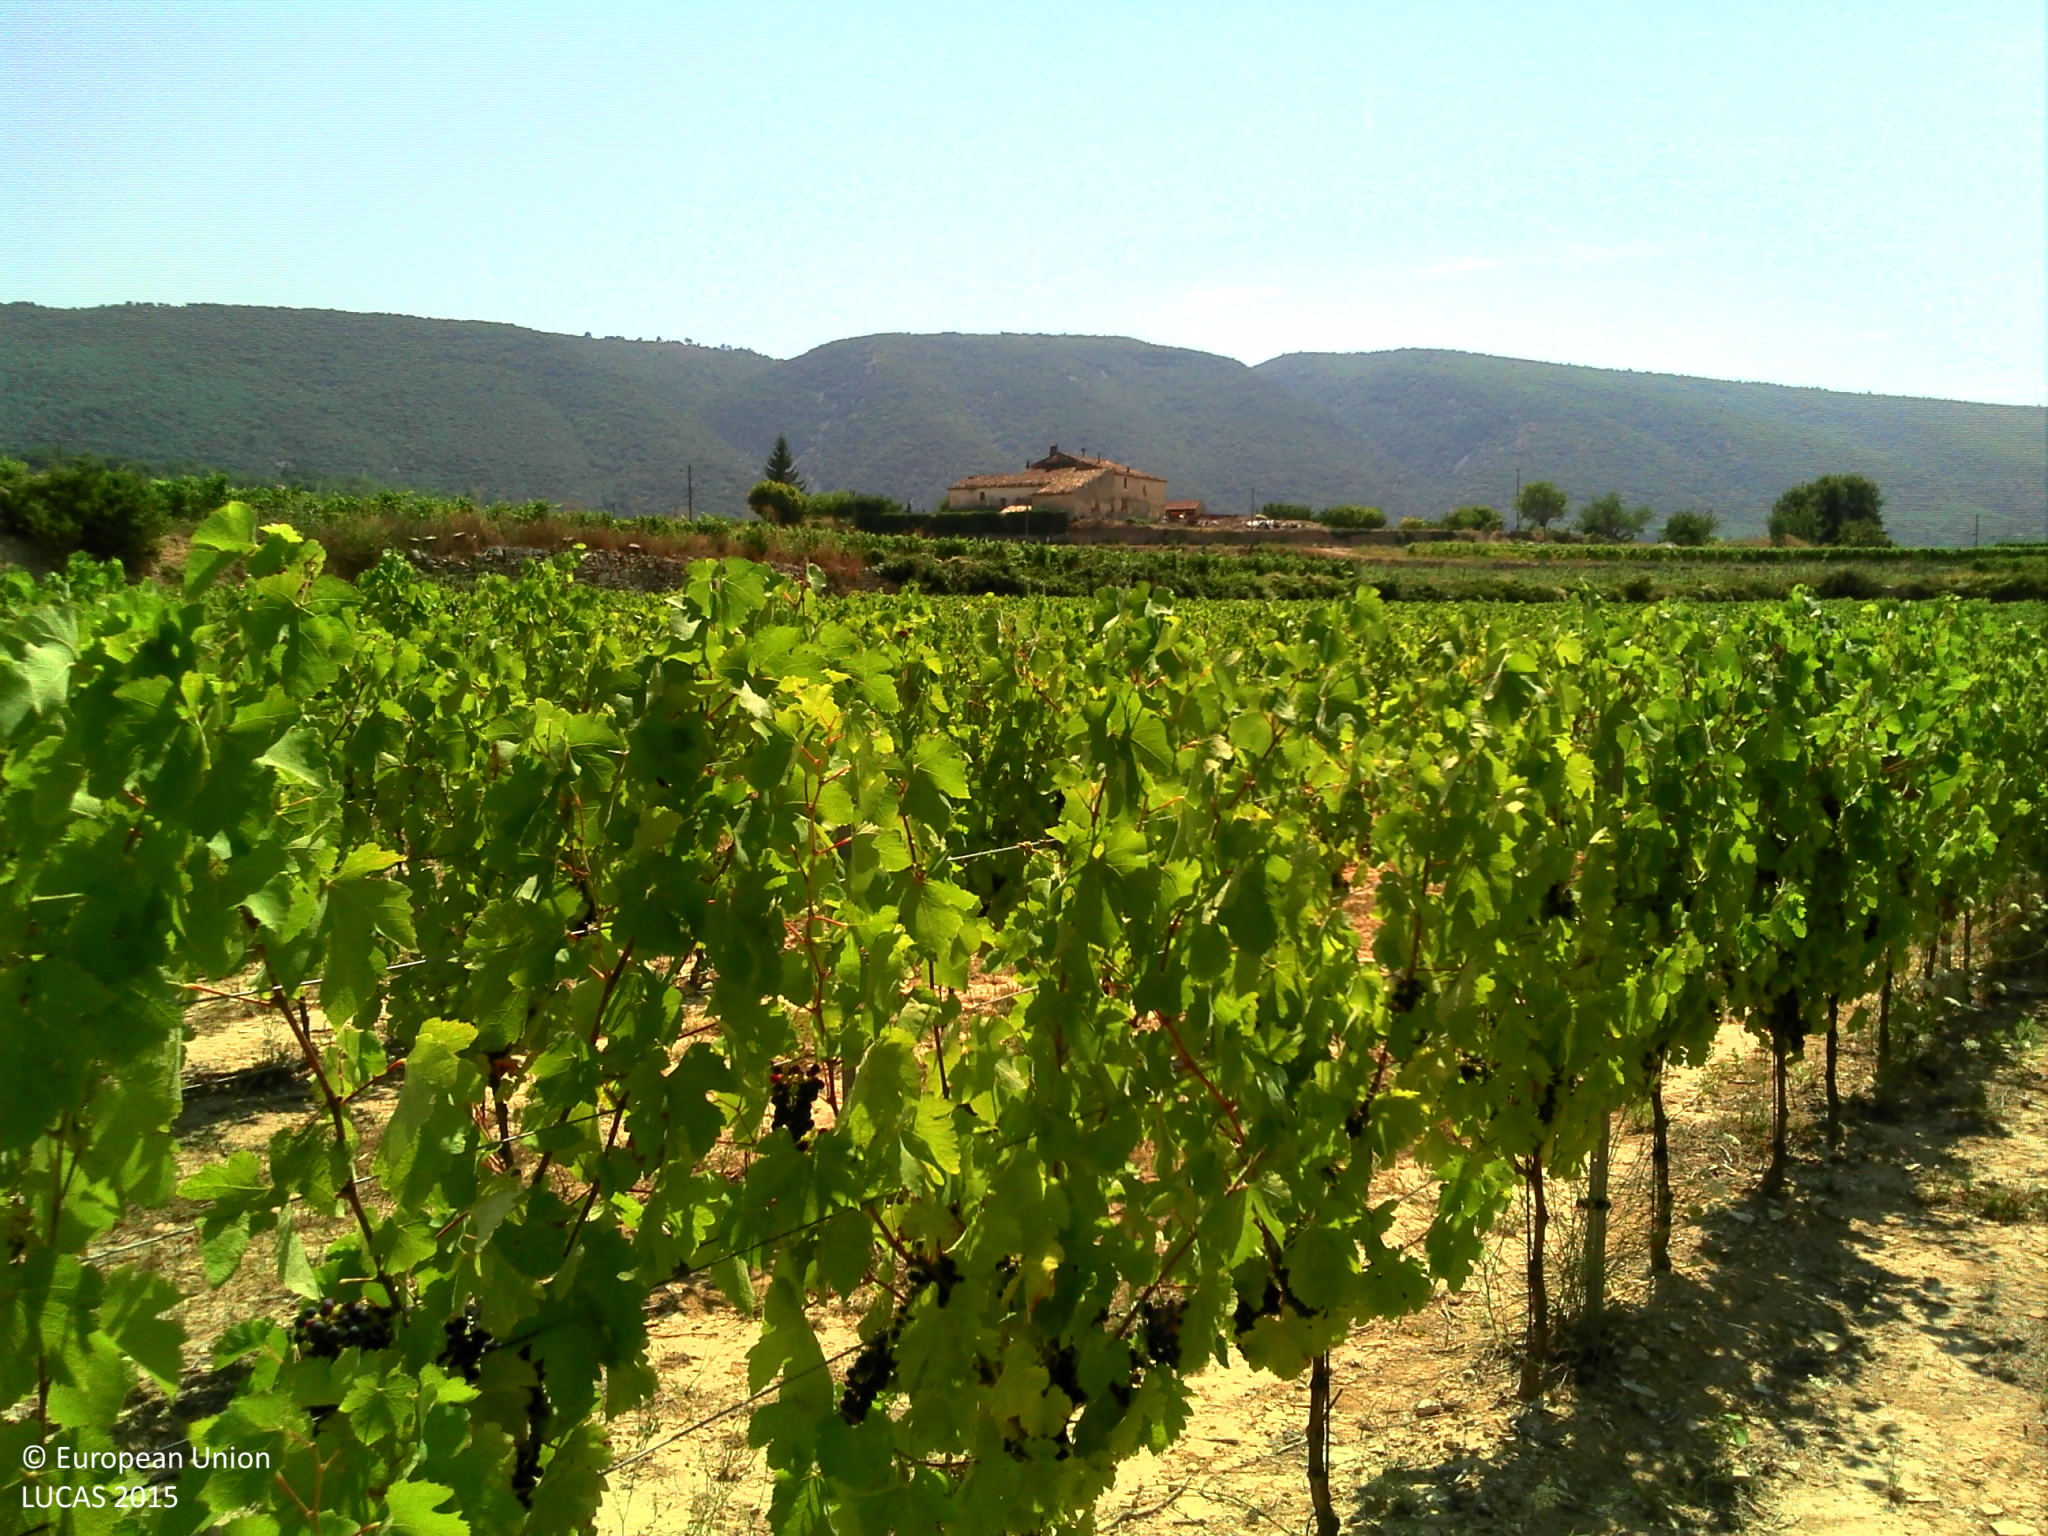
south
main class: Cropland
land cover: Vineyards
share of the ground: 25 - 50 %
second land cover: Other bare soil
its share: > 75 %
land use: Agriculture (excluding fallow land and kitchen gardens)
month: August
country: FR
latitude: 43.8284
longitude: 5.2960
